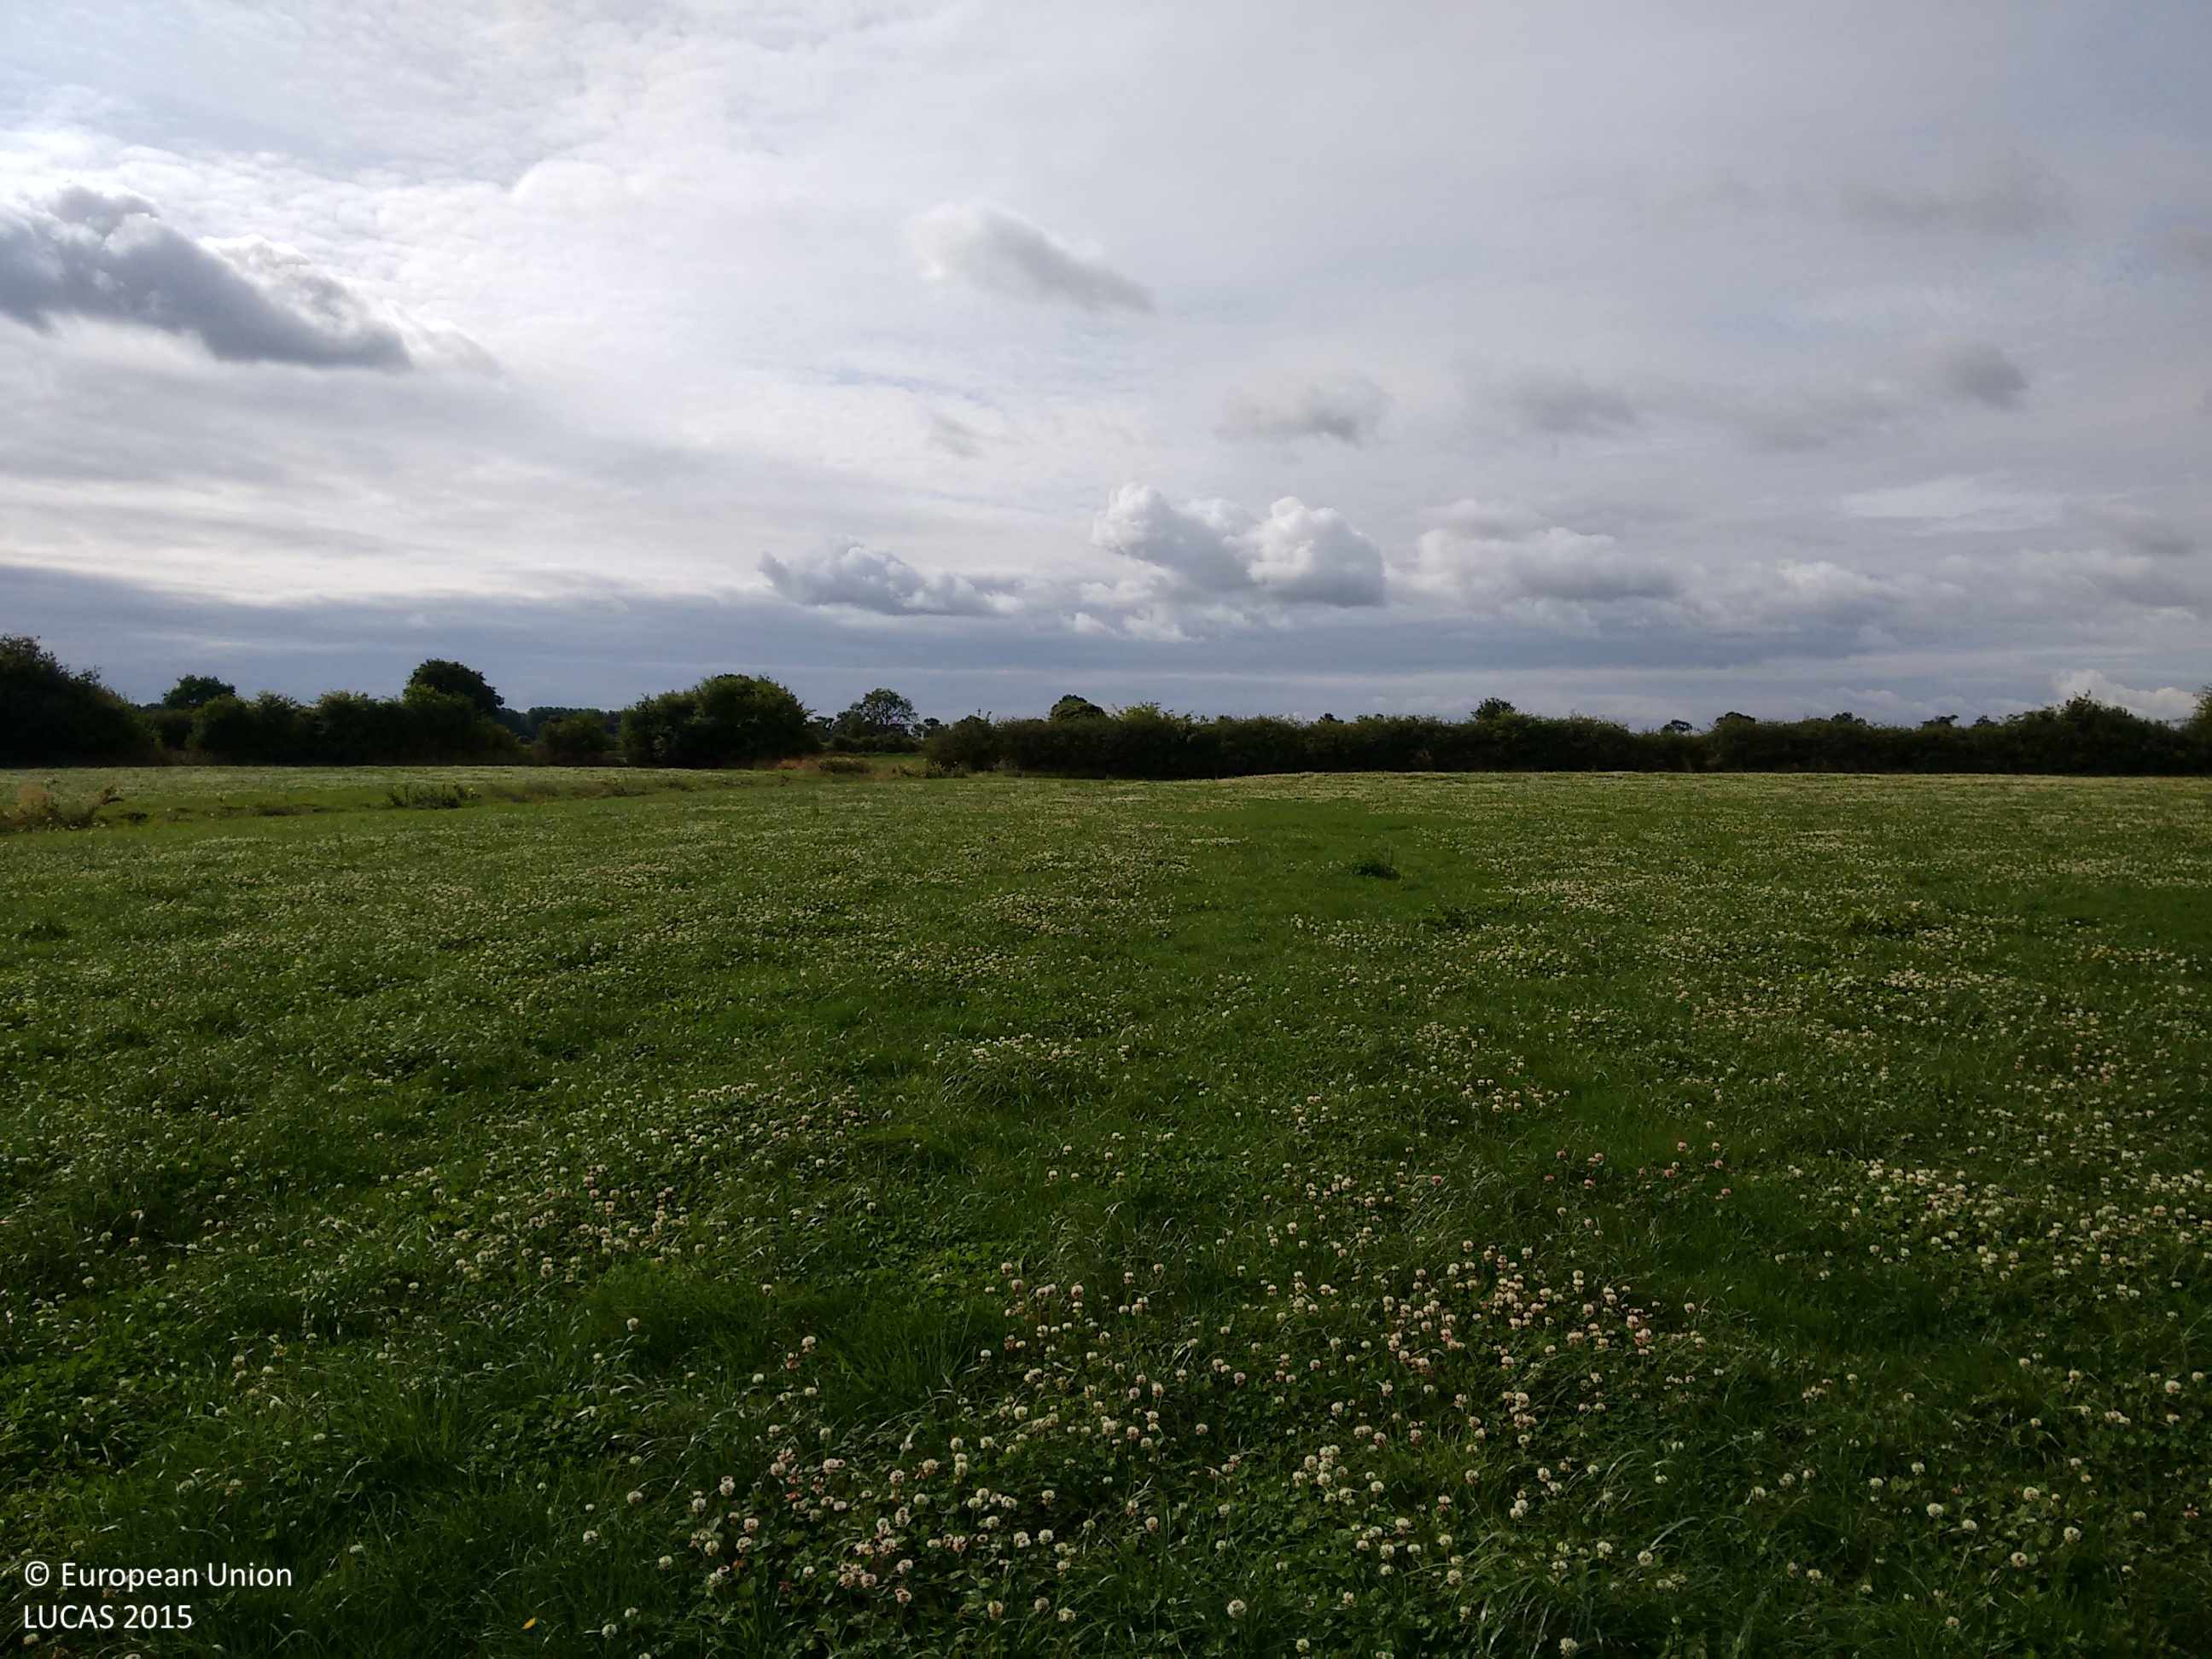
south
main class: Grassland
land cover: Grassland without tree/shrub cover
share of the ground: > 75 %
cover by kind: herbaceous plants 100 %
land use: Agriculture (excluding fallow land and kitchen gardens)
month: July
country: GB
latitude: 53.1085
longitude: -2.9047
